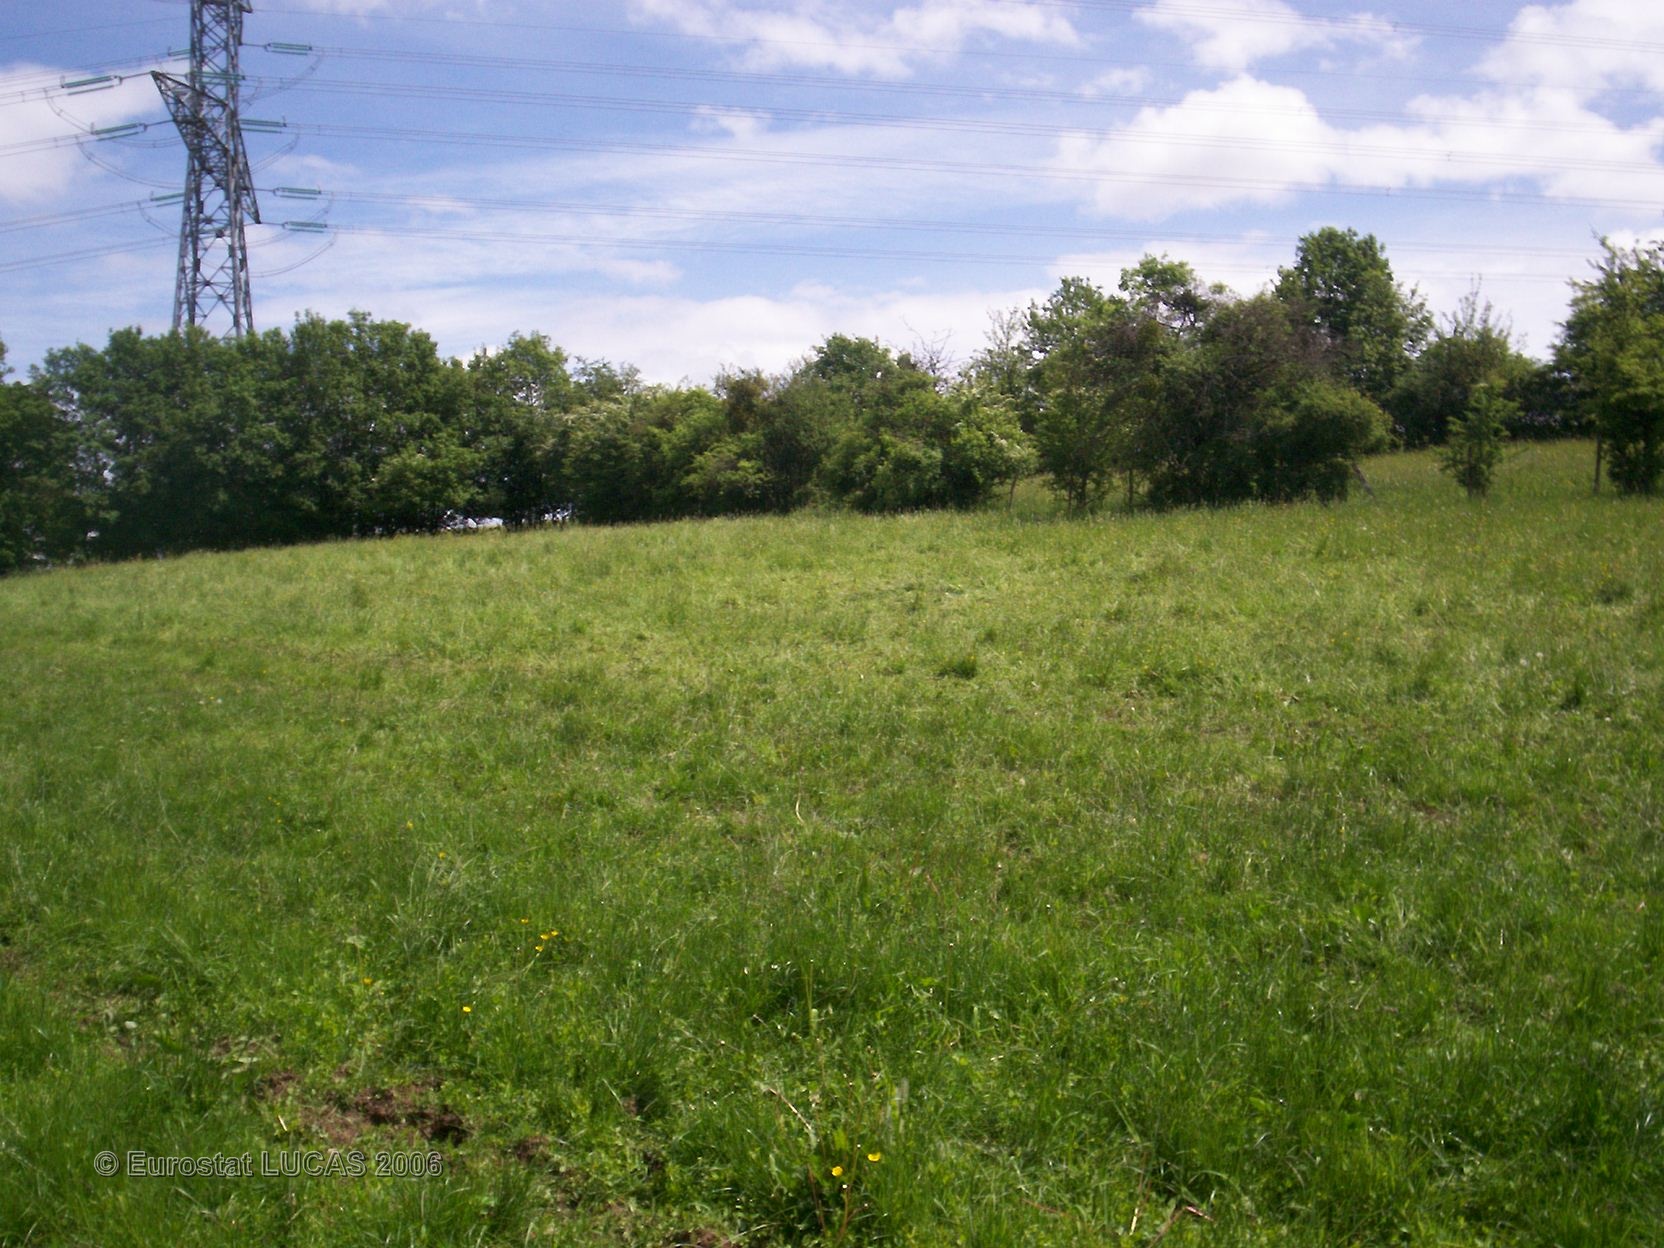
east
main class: Grassland
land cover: Grassland without tree/shrub cover
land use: Agriculture (excluding fallow land and kitchen gardens)
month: May
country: FR
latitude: 46.9907
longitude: 4.5962
